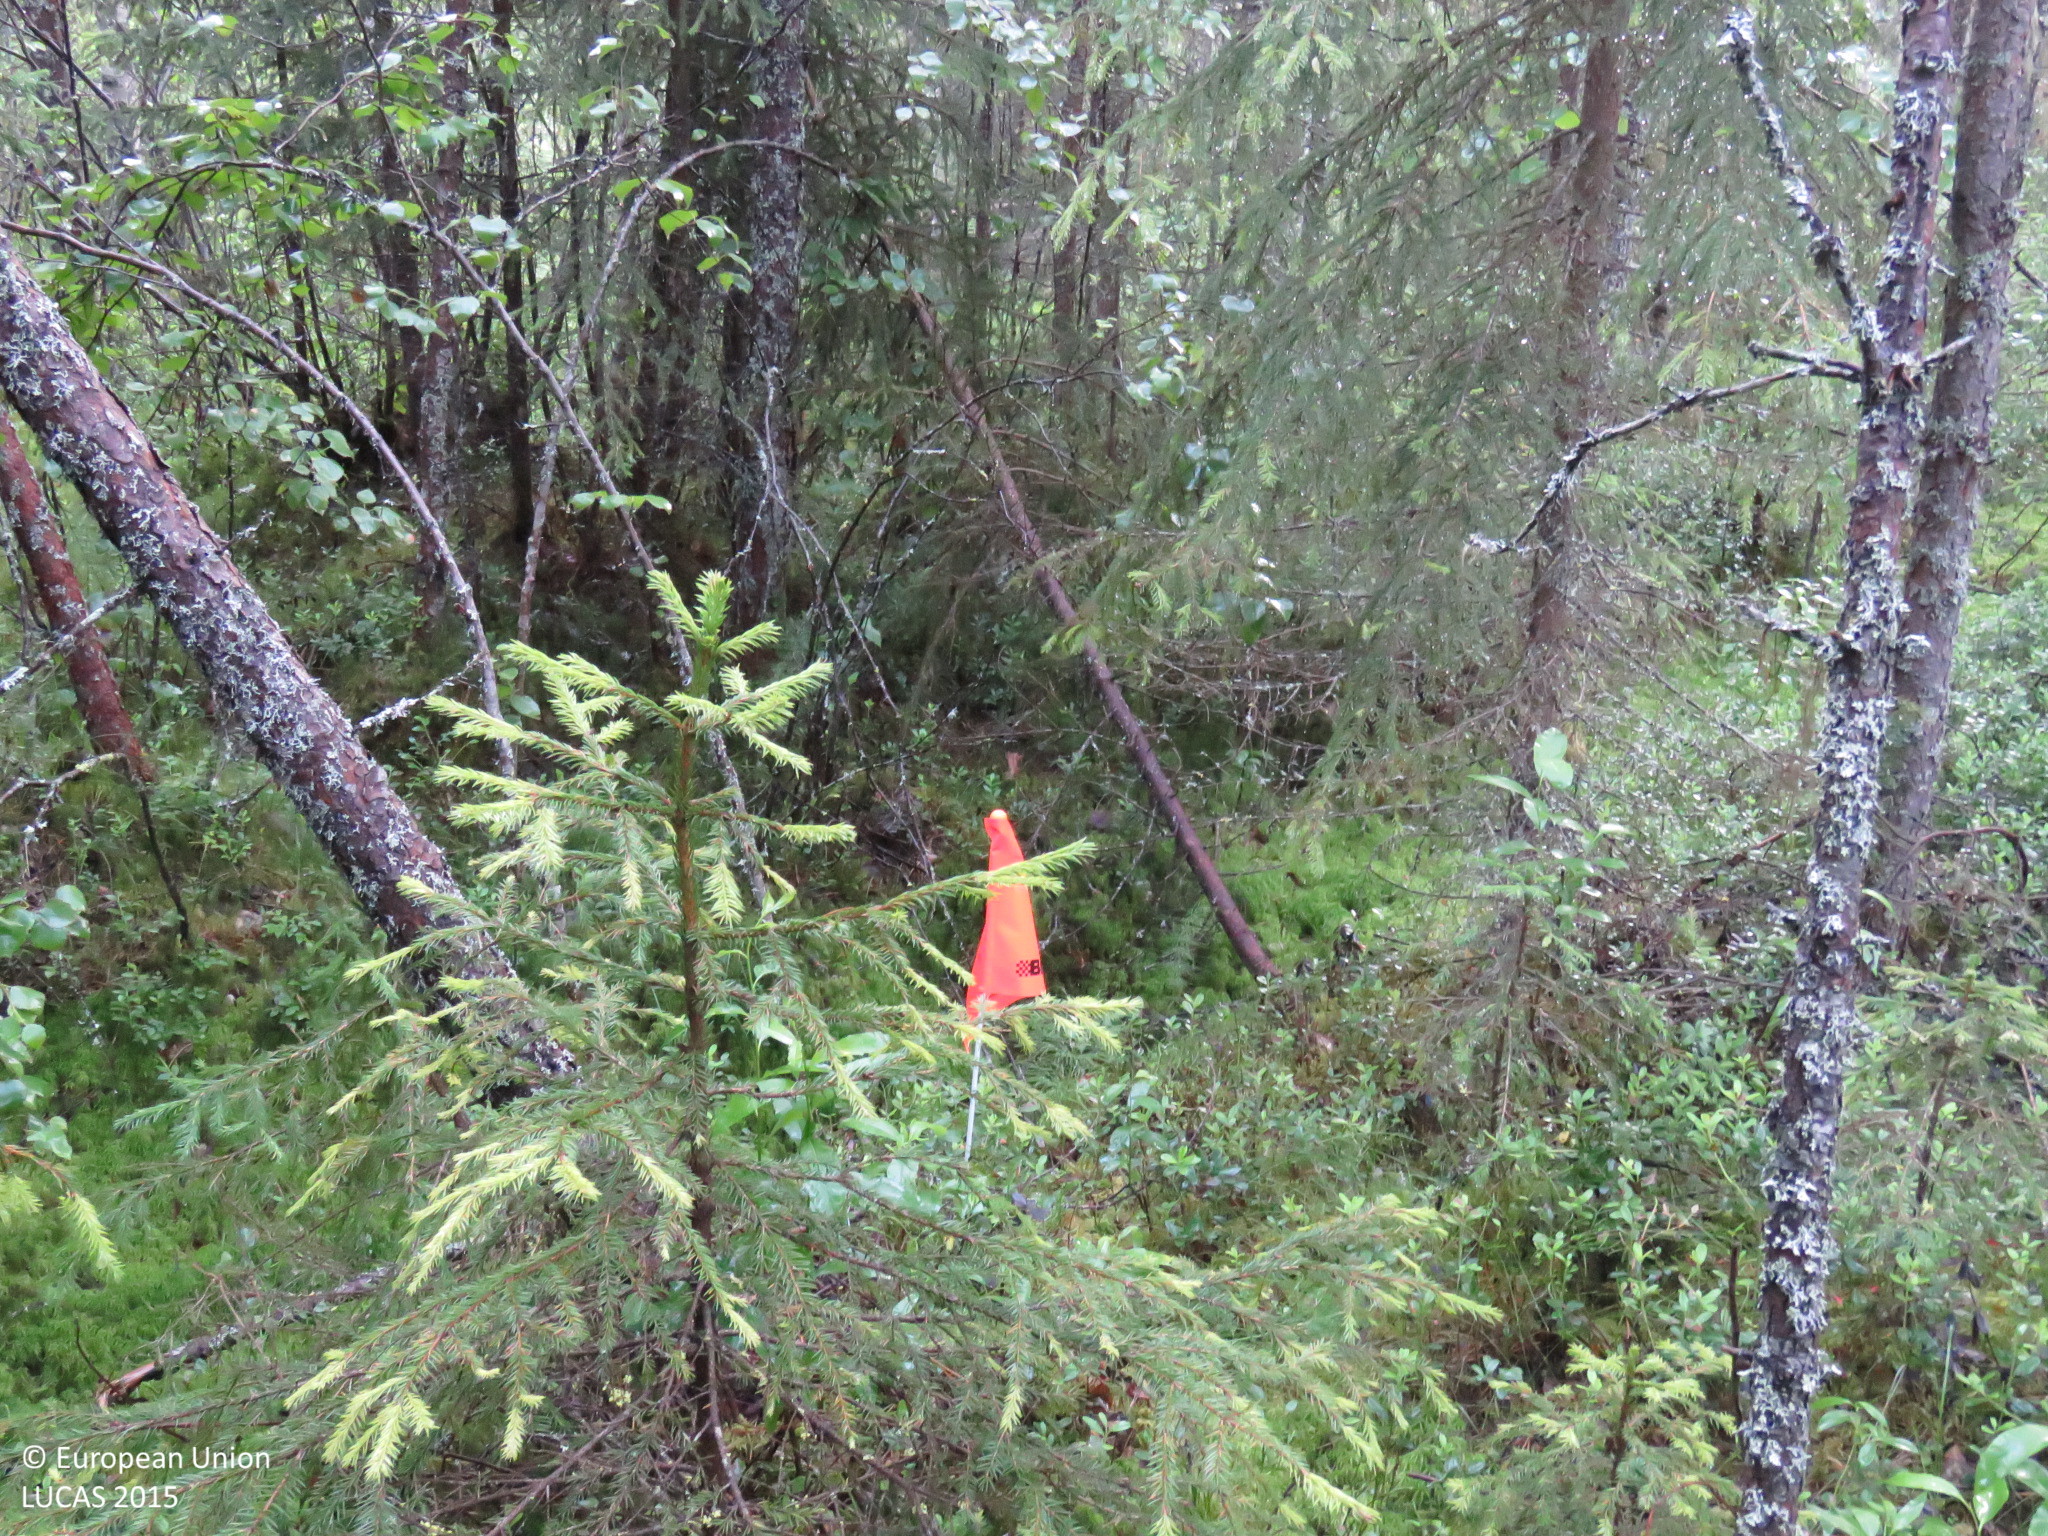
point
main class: Woodland
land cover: Spruce dominated mixed woodland
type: boreal forest
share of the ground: > 75 %
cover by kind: coniferous forest trees 65 %, broadleaved forest trees 25 %, shrubs 10 %
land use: Forestry
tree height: > 5 m
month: July
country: FI
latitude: 64.1592
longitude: 26.4654
